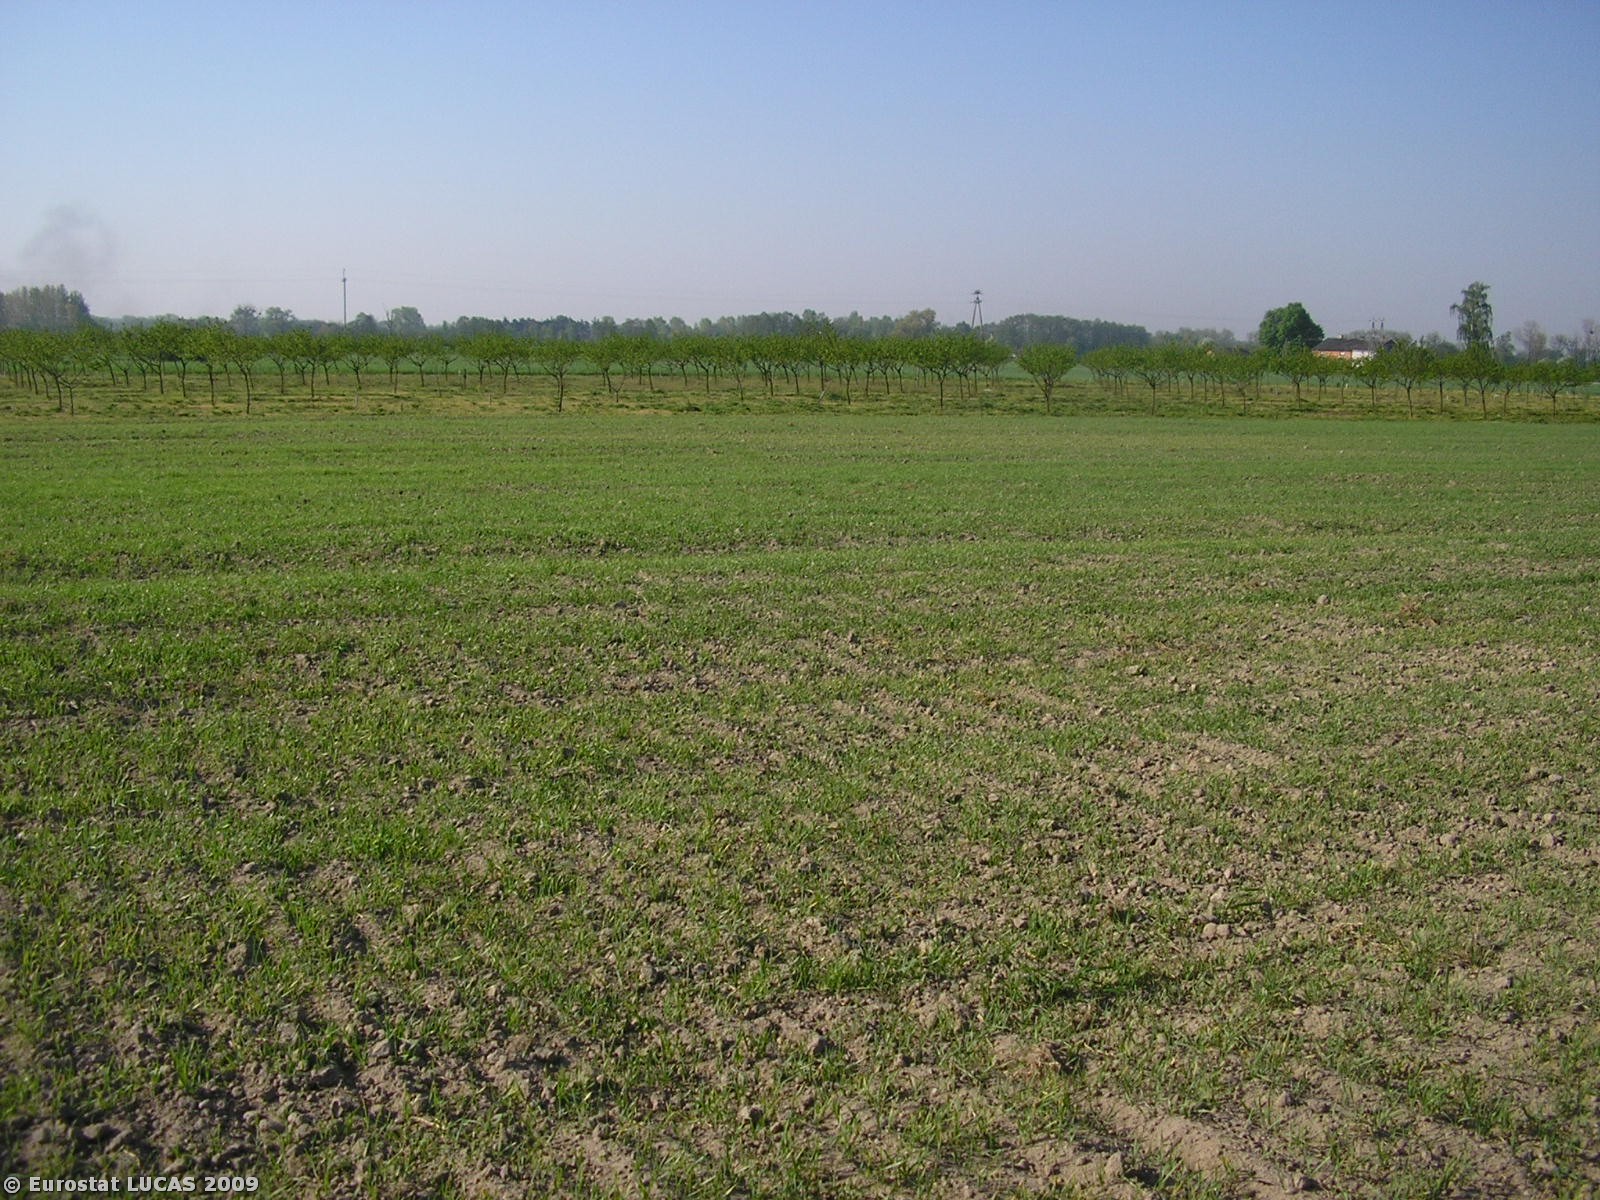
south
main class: Cropland
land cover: Mixed cereals for fodder
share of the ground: < 10 %
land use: Agriculture (excluding fallow land and kitchen gardens)
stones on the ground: < 10 %
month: April
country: PL
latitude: 52.2109
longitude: 20.1765
